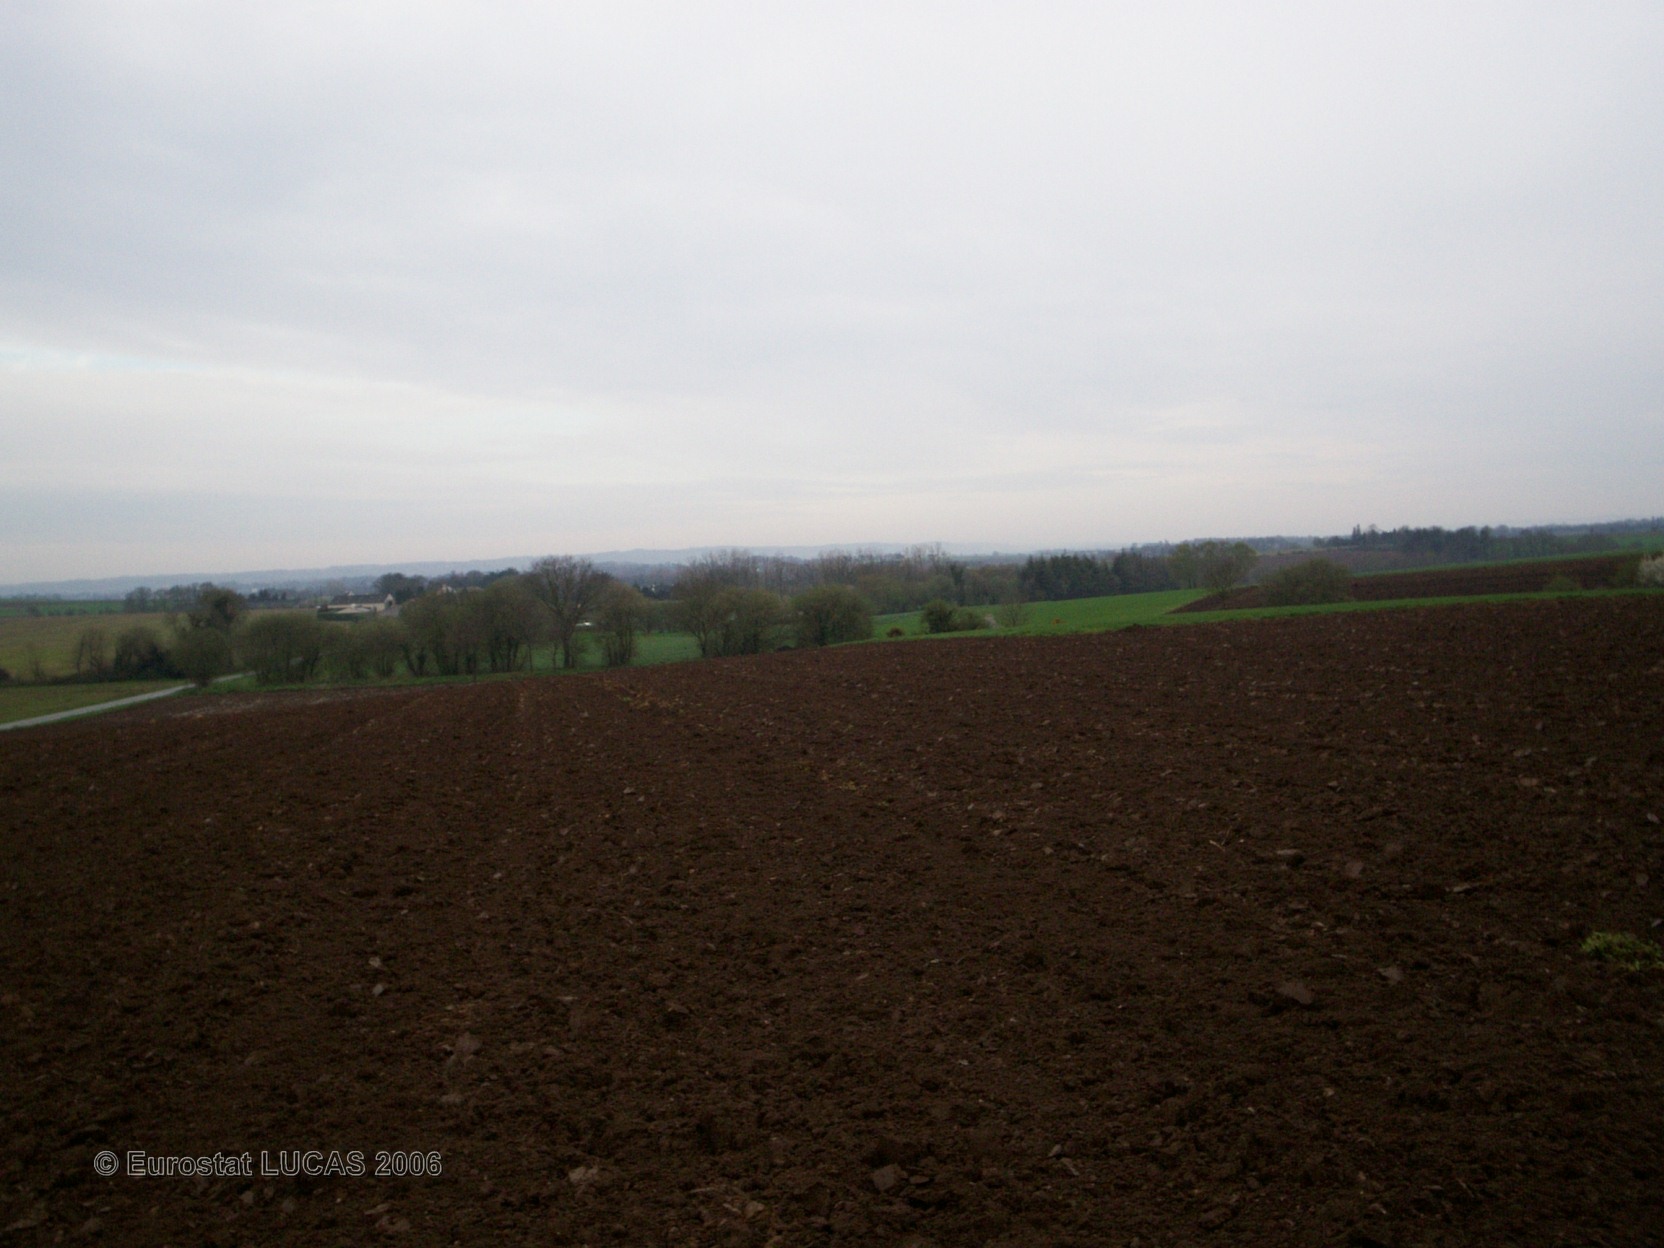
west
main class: Cropland
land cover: Maize
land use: Agriculture (excluding fallow land and kitchen gardens)
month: May
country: FR
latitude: 48.0829
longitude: -2.8862
